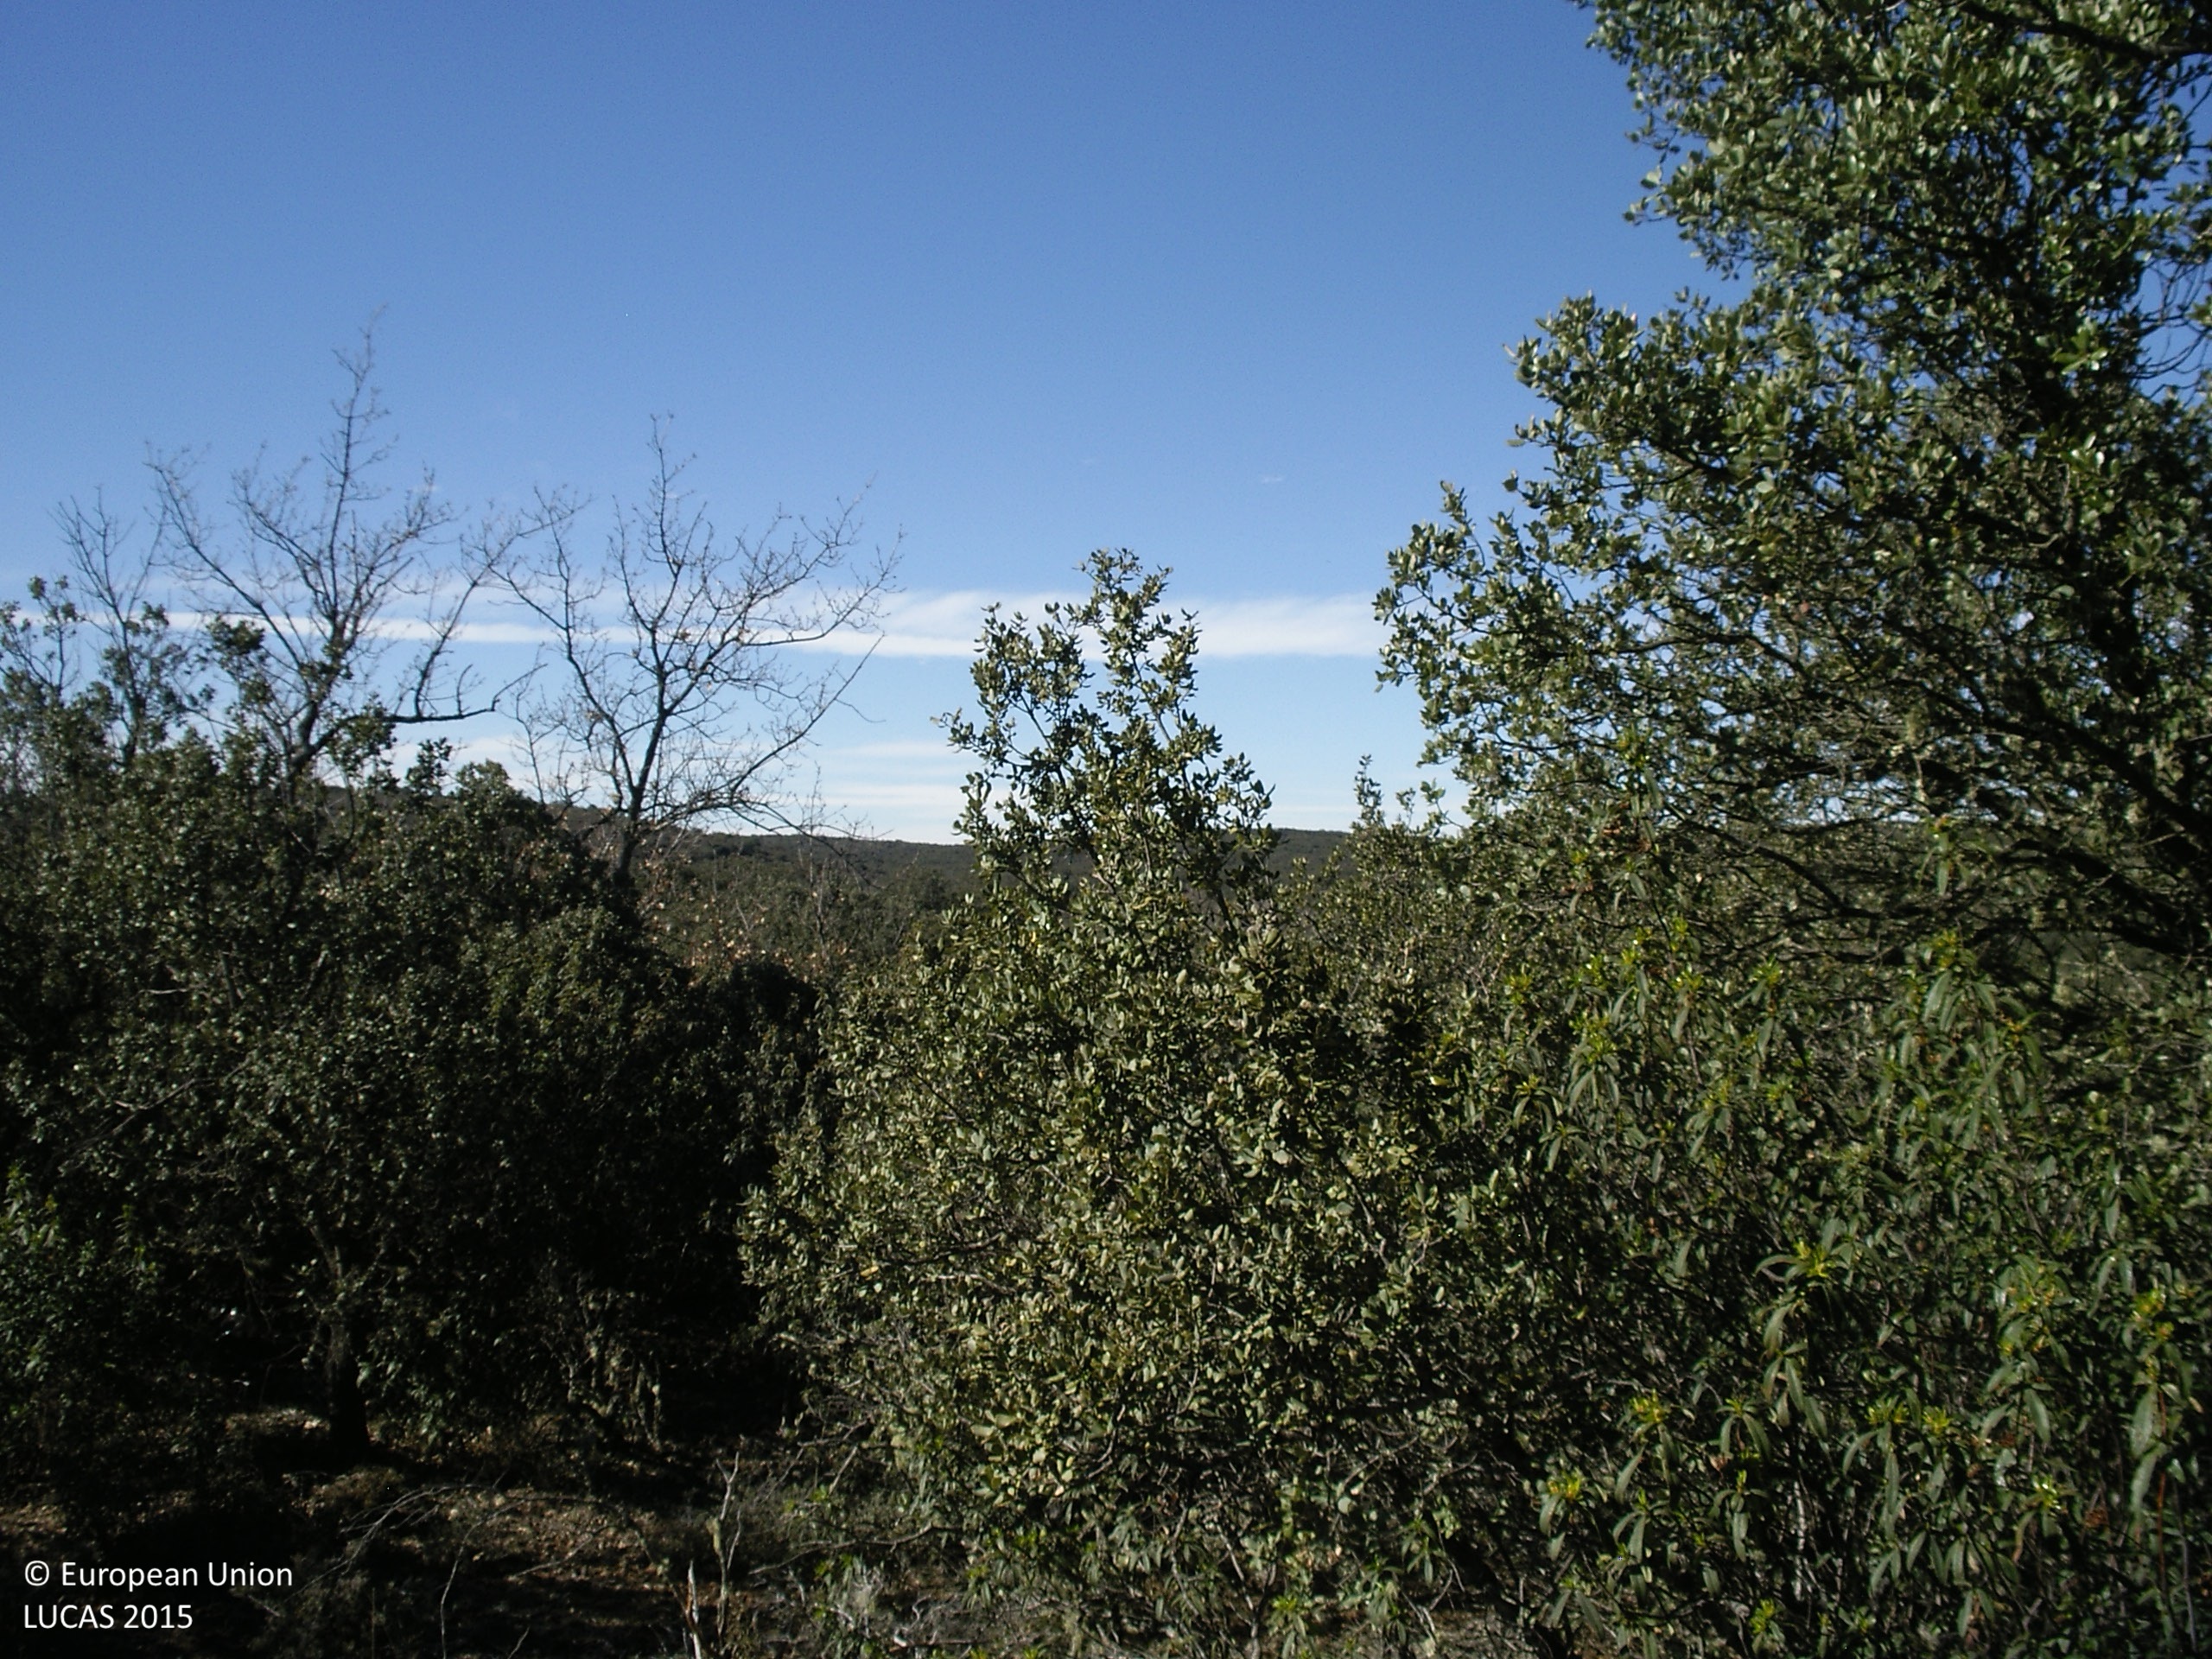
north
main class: Woodland
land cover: Broadleaved woodland
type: broadleaved evergreen forest
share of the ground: > 75 %
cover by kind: broadleaved forest trees 90 %, shrubs 10 %
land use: Forestry
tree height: > 5 m
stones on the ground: 10 - 25 %
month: March
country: ES
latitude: 42.3398
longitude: -6.0406
